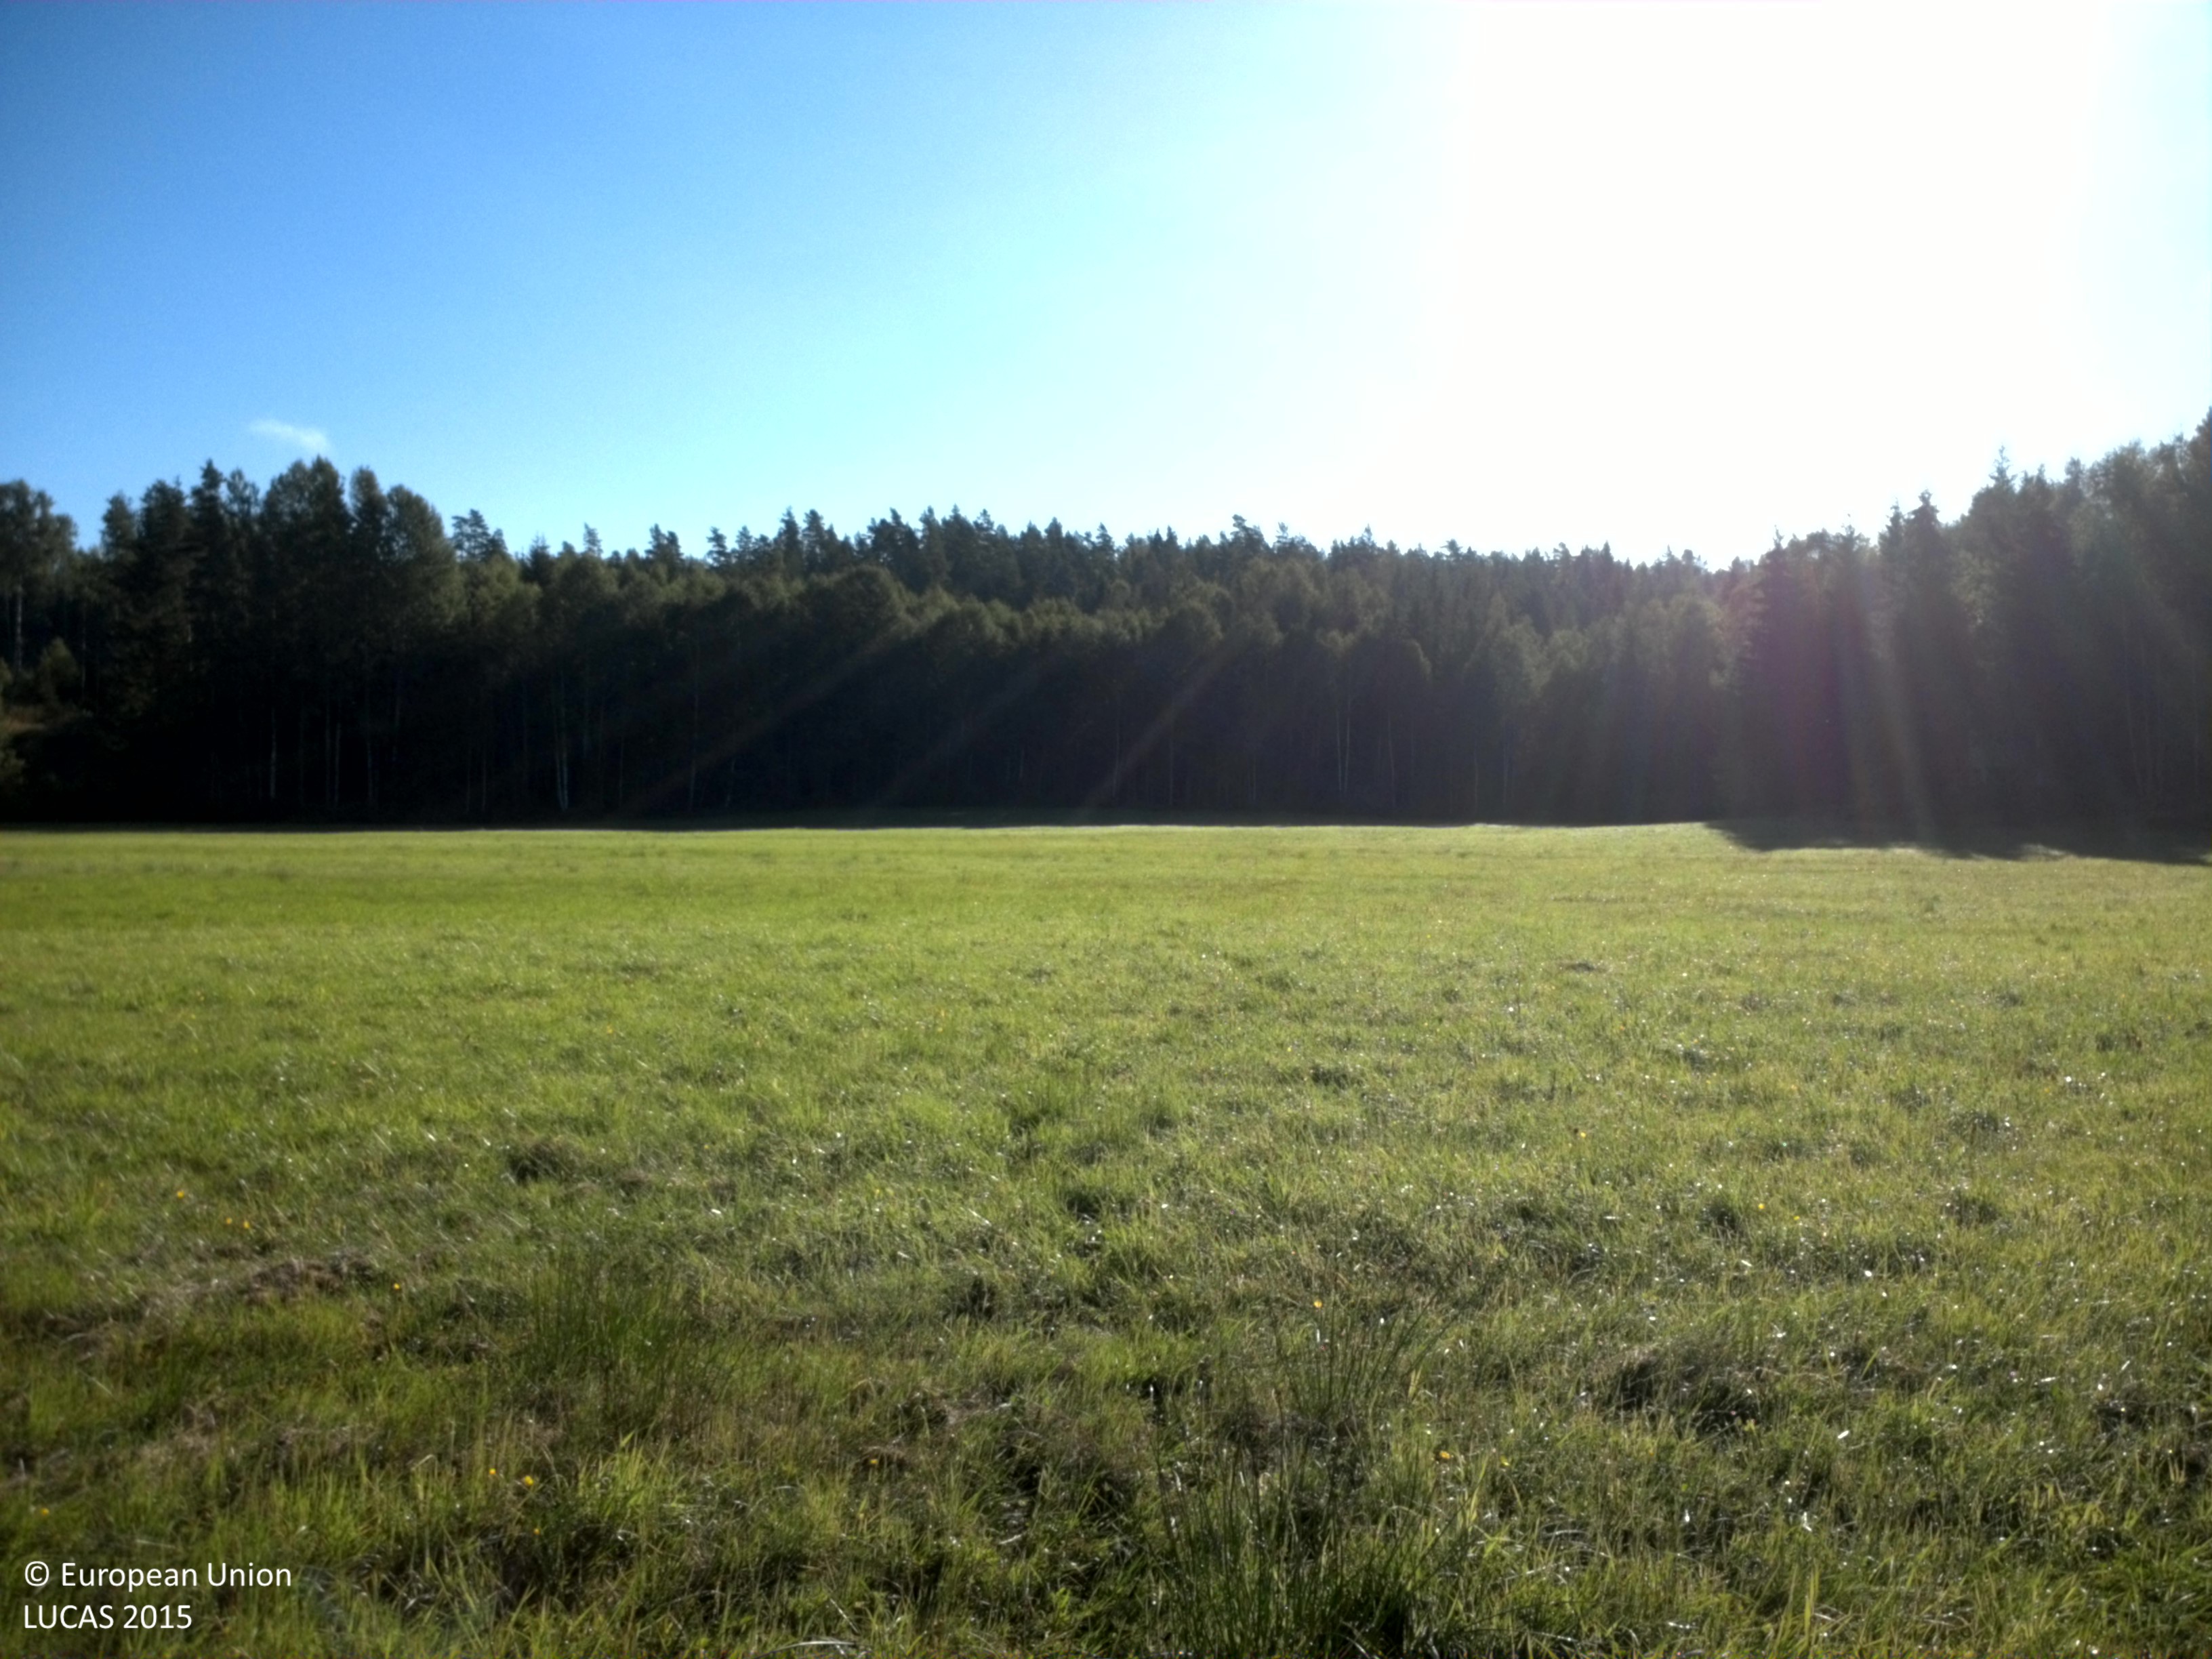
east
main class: Grassland
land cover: Grassland without tree/shrub cover
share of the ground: > 75 %
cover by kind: herbaceous plants 90 %, consolidated bare surface 10 %
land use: Agriculture (excluding fallow land and kitchen gardens)
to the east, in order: Grassland without tree/shrub cover; Spruce dominated mixed woodland; Spruce dominated coniferous woodland
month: August
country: SE
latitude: 59.4714
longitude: 13.4689
